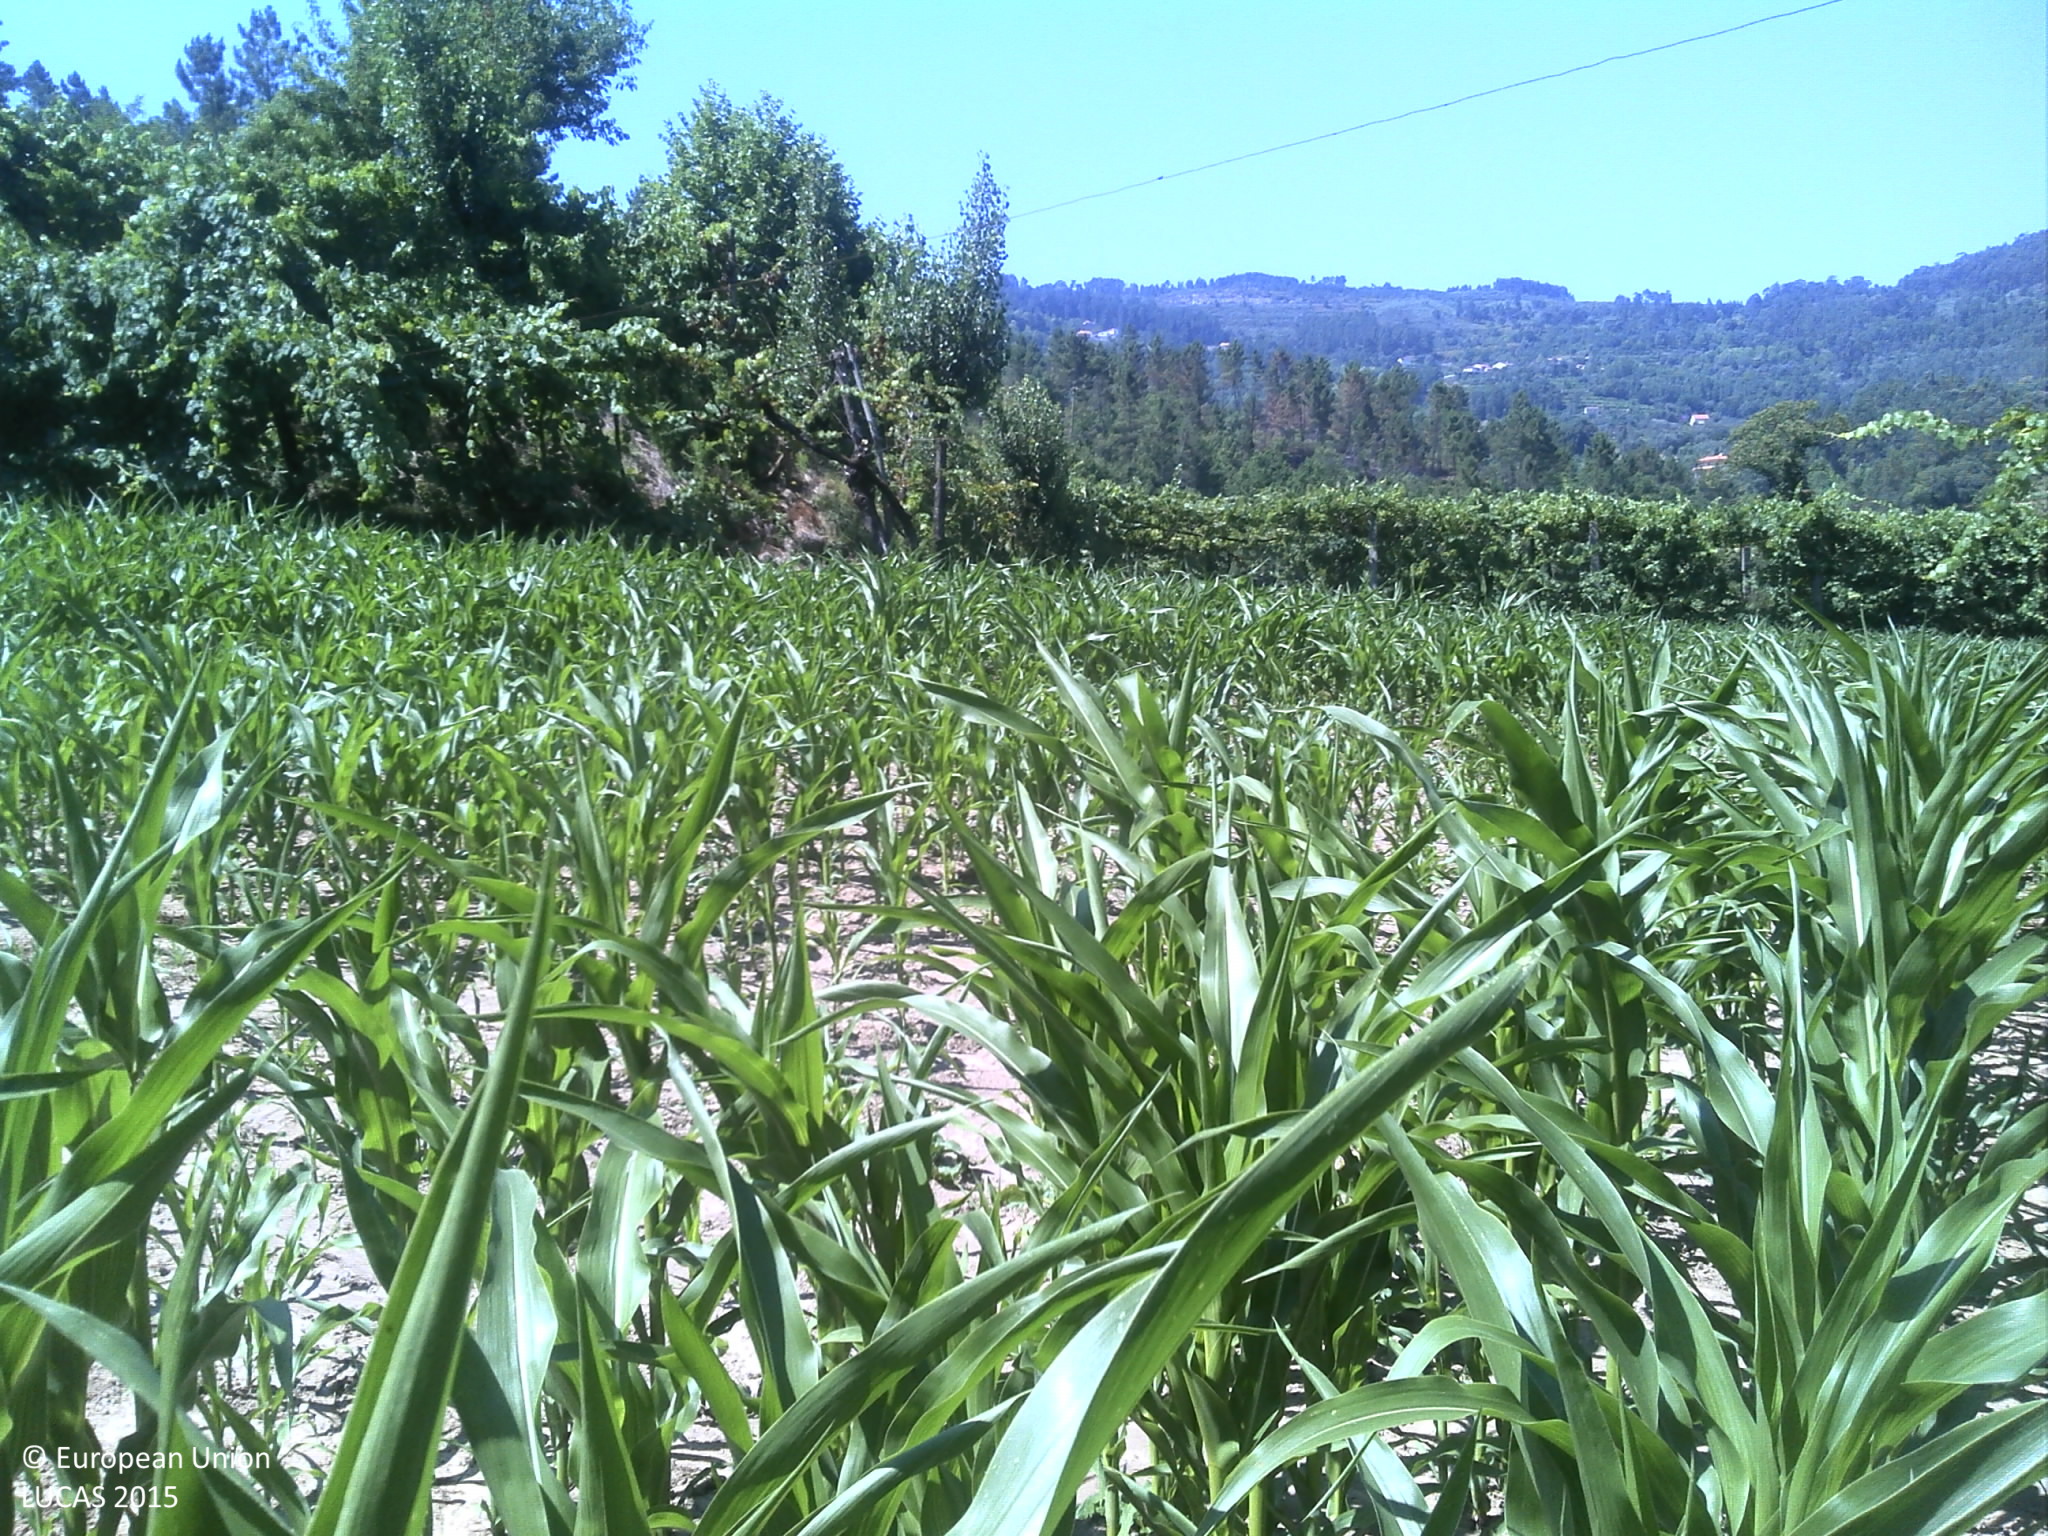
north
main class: Cropland
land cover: Maize
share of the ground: > 75 %
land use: Agriculture (excluding fallow land and kitchen gardens)
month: June
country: PT
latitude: 41.4481
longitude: -8.0114
